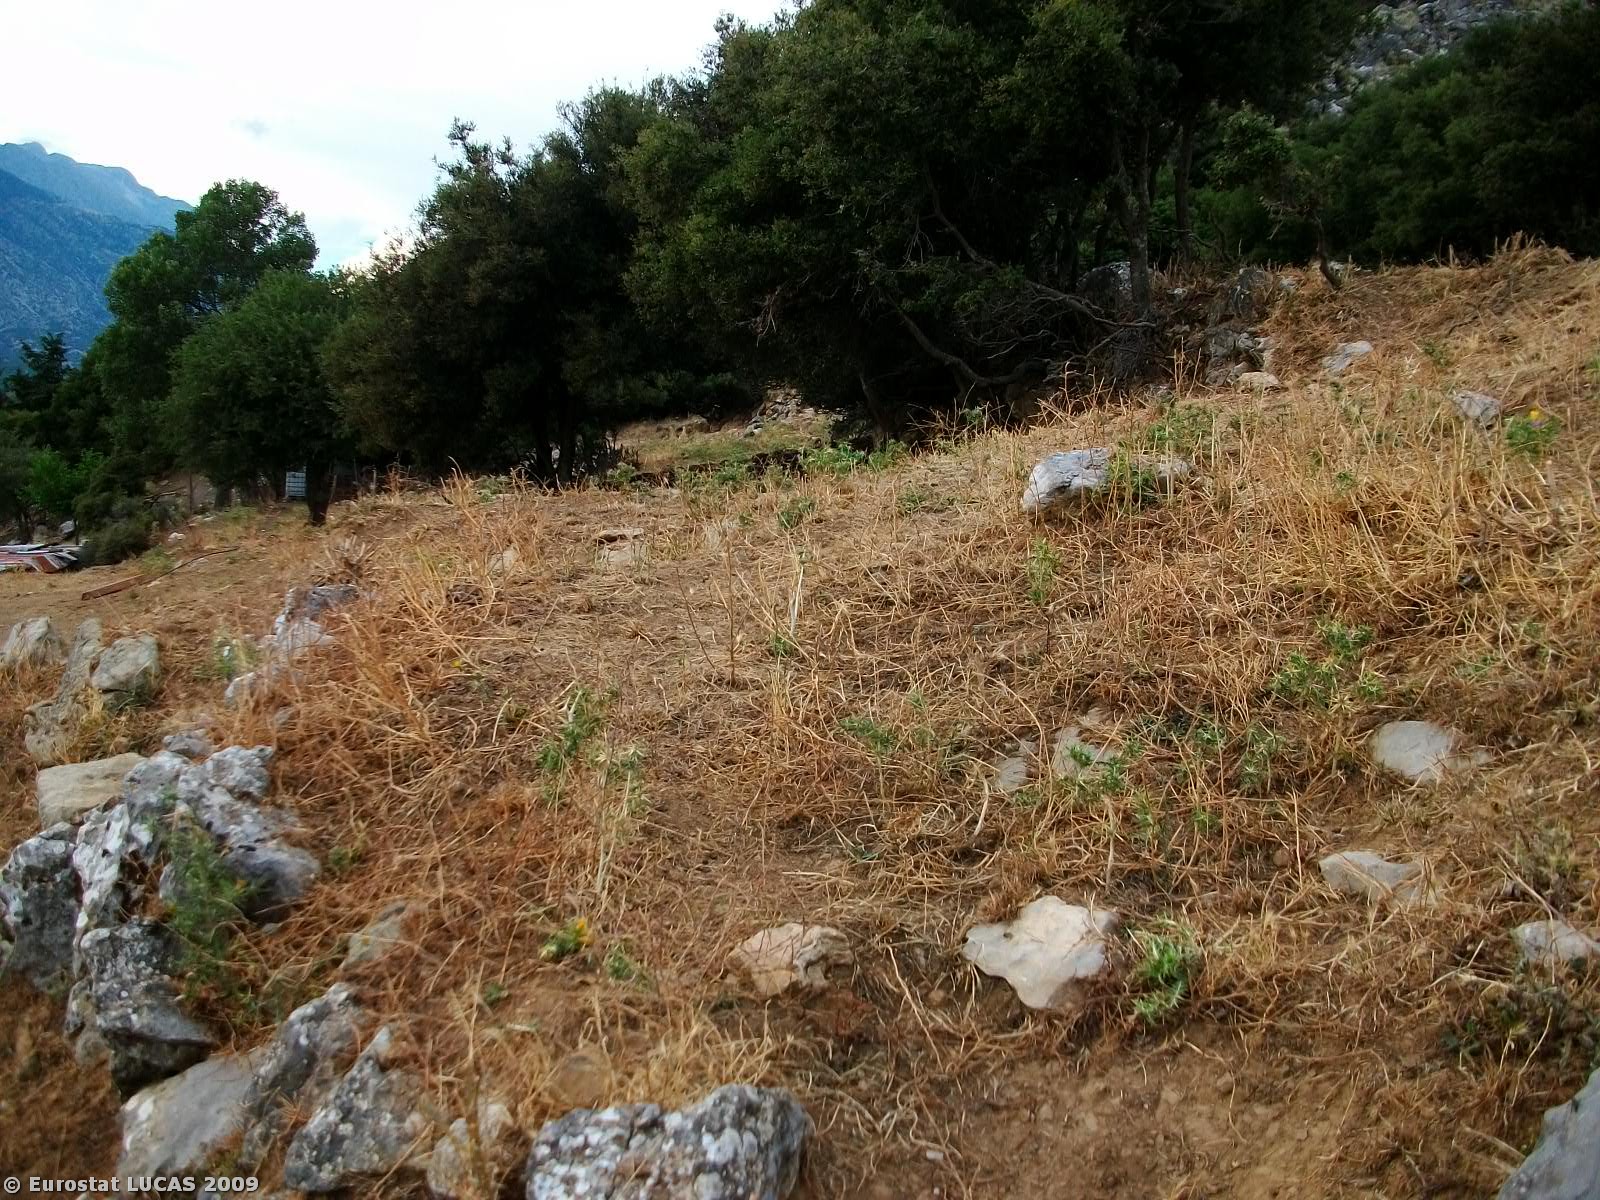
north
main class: Grassland
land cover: Grassland with sparse tree/shrub cover
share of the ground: 50 - 75 %
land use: Agriculture (excluding fallow land and kitchen gardens)
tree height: < 5 m
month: June
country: GR
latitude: 38.5525
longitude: 22.1950
